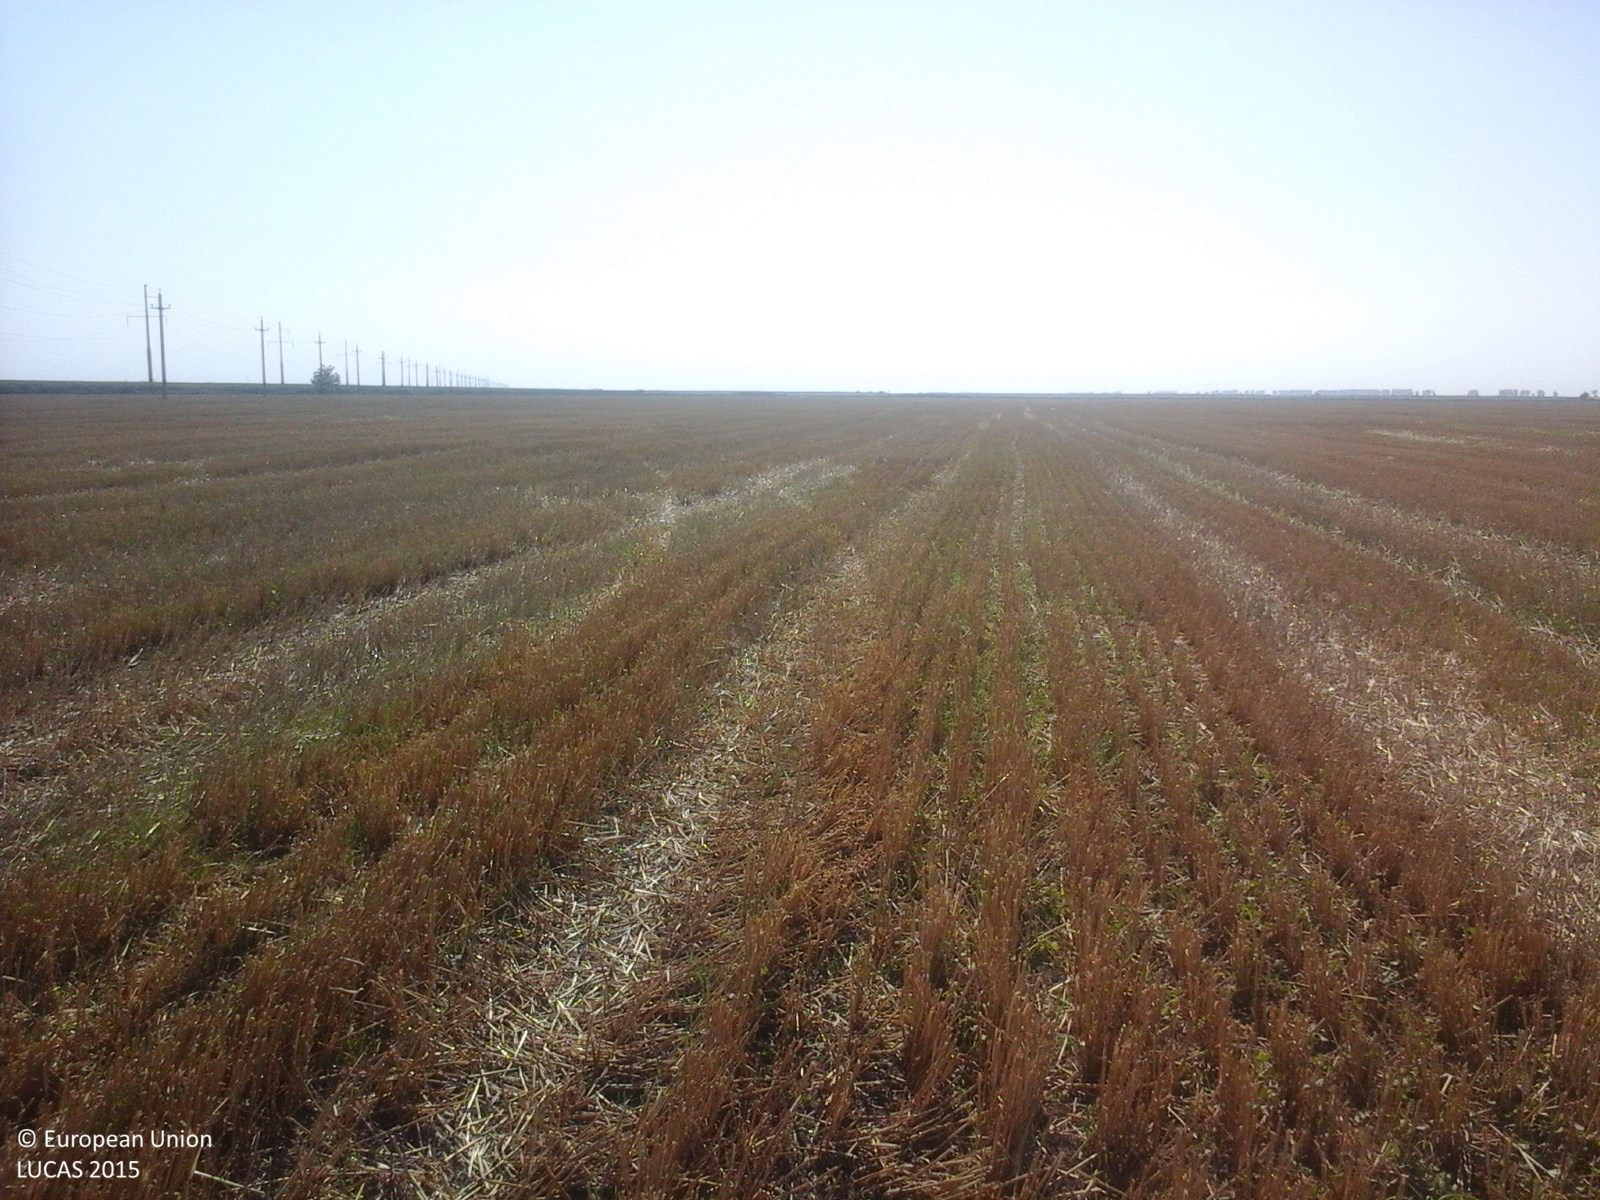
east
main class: Cropland
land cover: Durum wheat
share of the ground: > 75 %
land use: Agriculture (excluding fallow land and kitchen gardens)
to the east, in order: Durum wheat
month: July
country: RO
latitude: 44.4540
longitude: 27.1612
